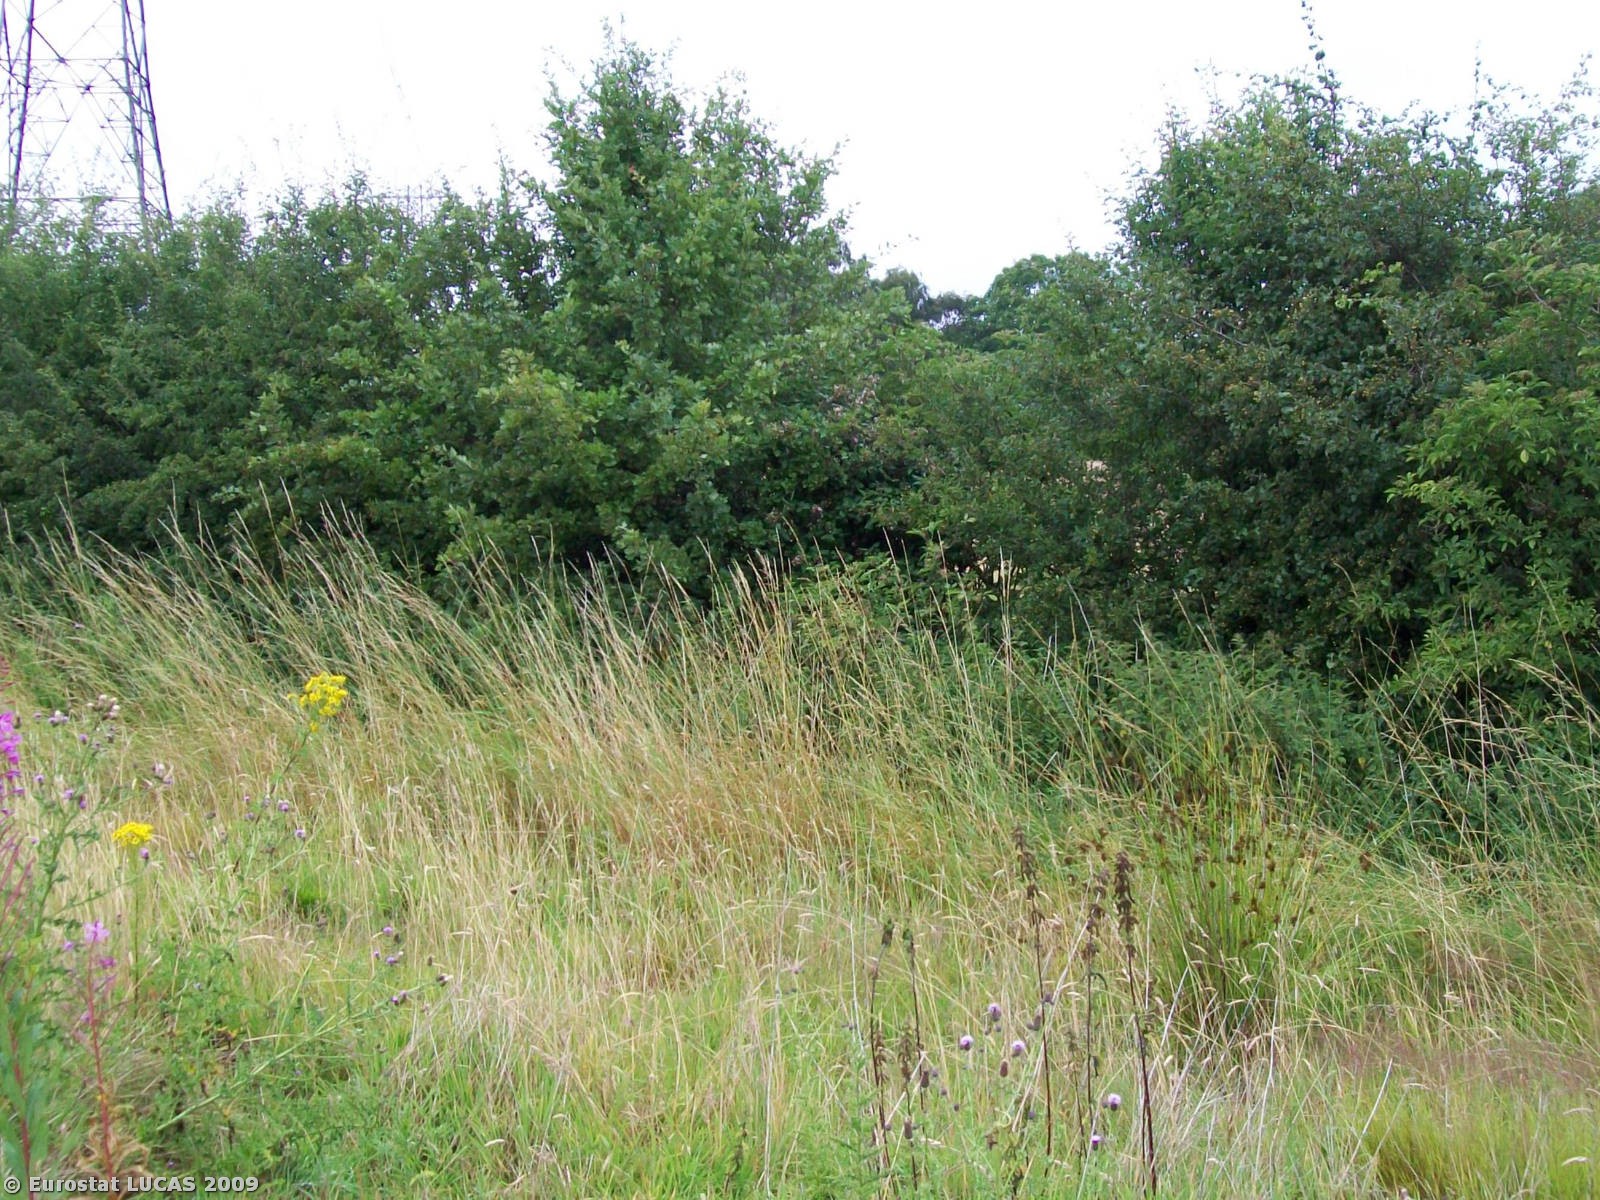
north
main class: Grassland
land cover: Grassland without tree/shrub cover
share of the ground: > 75 %
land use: Agriculture (excluding fallow land and kitchen gardens)
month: July
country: GB
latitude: 52.7027
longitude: -1.1602
